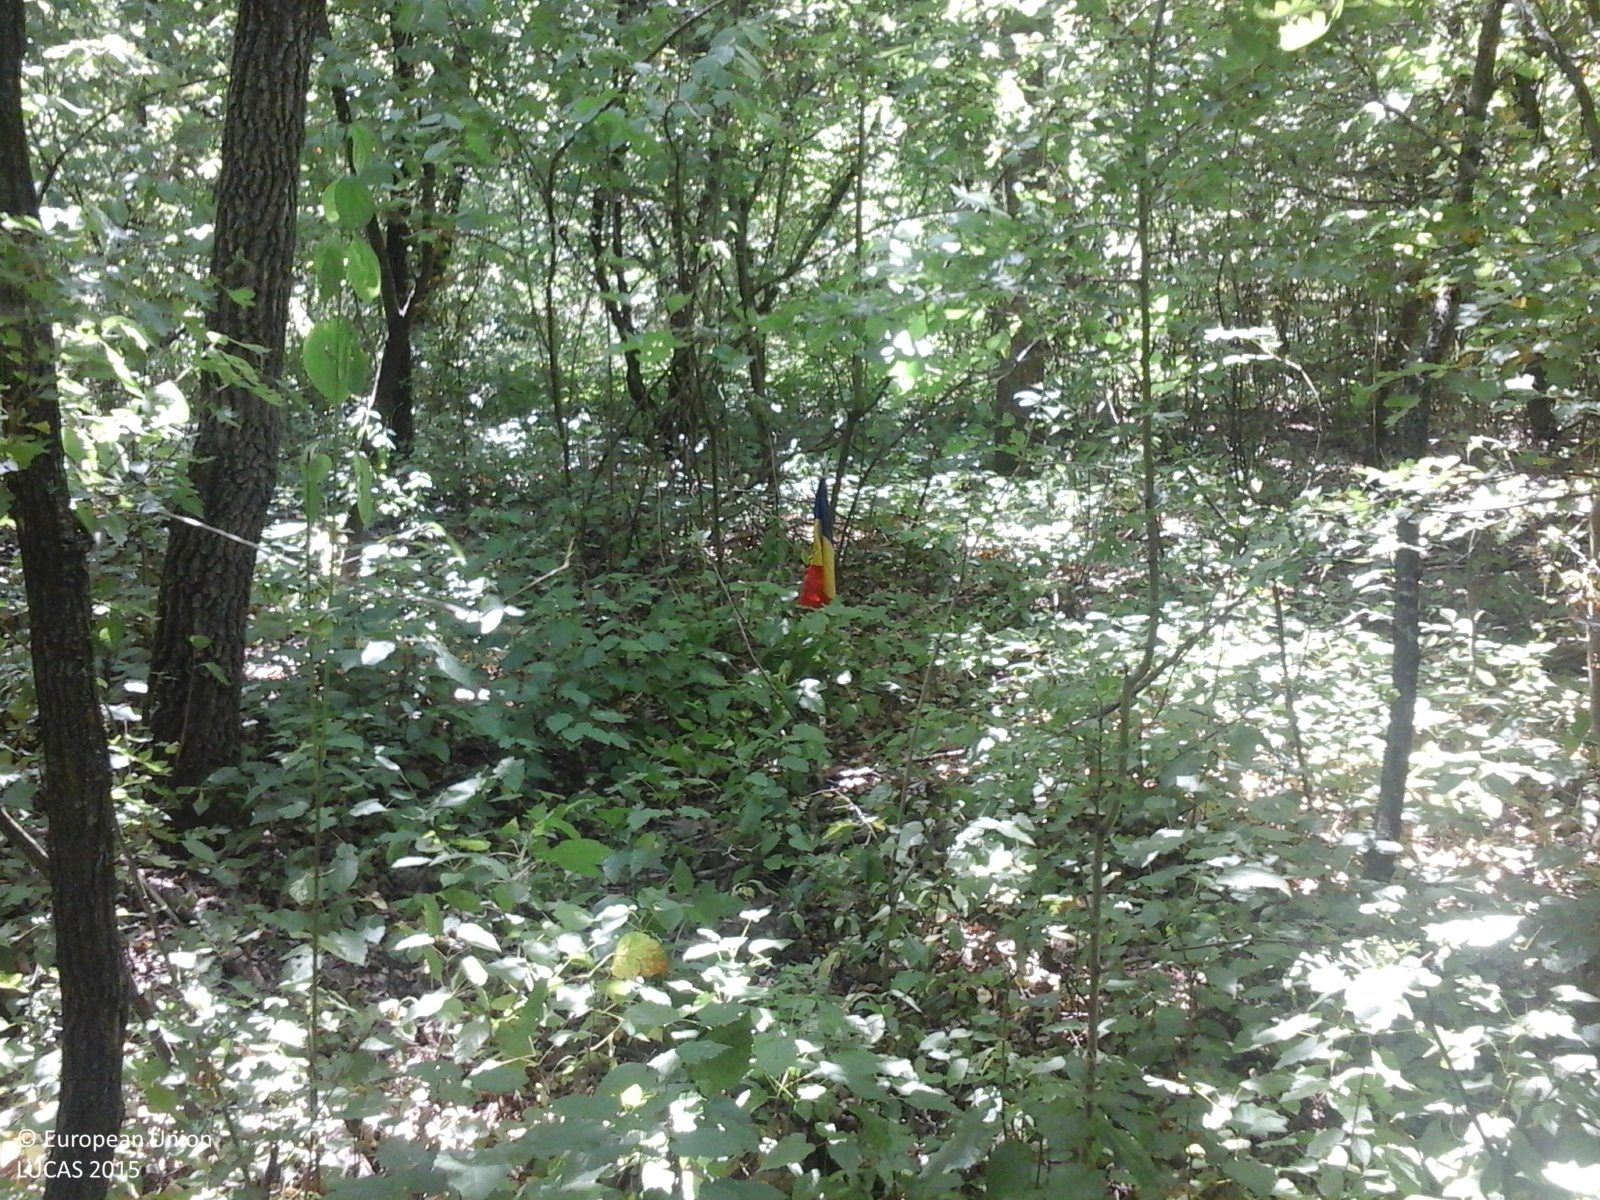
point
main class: Woodland
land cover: Broadleaved woodland
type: acidophilous oak and oak-birch forest
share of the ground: > 75 %
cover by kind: broadleaved forest trees 100 %
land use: Forestry
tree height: > 5 m
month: July
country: RO
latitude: 44.2411
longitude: 26.5553
